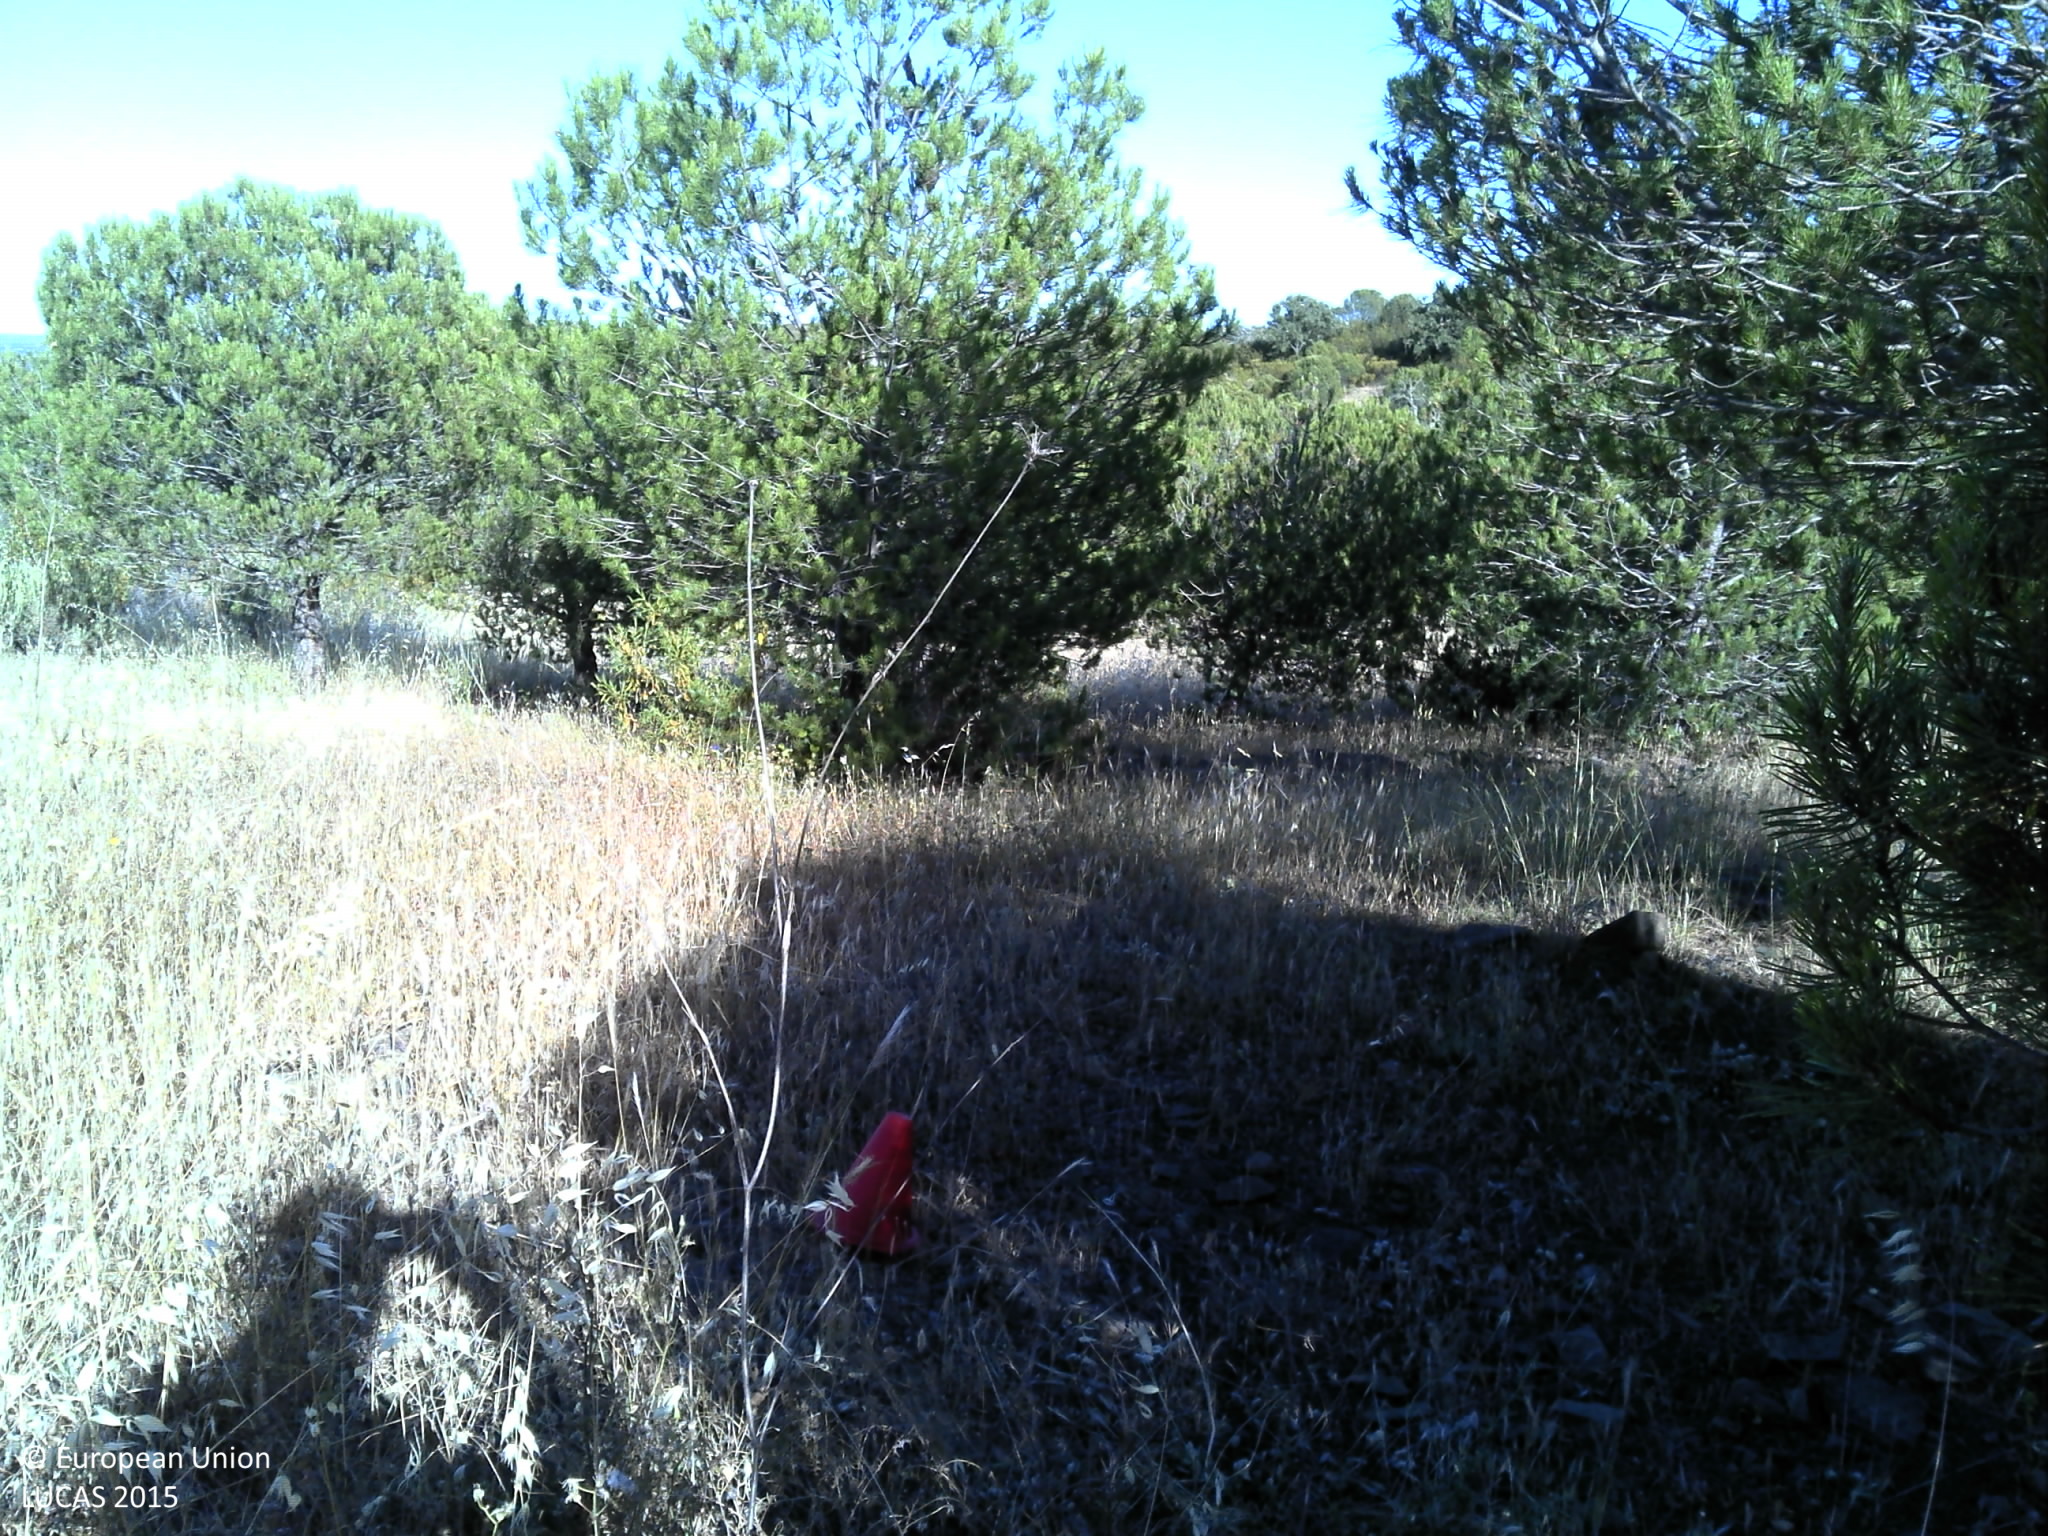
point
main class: Woodland
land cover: Pine dominated coniferous woodland
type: coniferous forest of the mediterranean region
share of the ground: 25 - 50 %
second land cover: Grassland without tree/shrub cover
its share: 50 - 75 %
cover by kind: herbaceous plants 40 %, coniferous forest trees 35 %, shrubs 25 %
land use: Forestry
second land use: Agriculture (excluding fallow land and kitchen gardens)
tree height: < 5 m
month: May
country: PT
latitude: 37.4439
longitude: -7.4938
